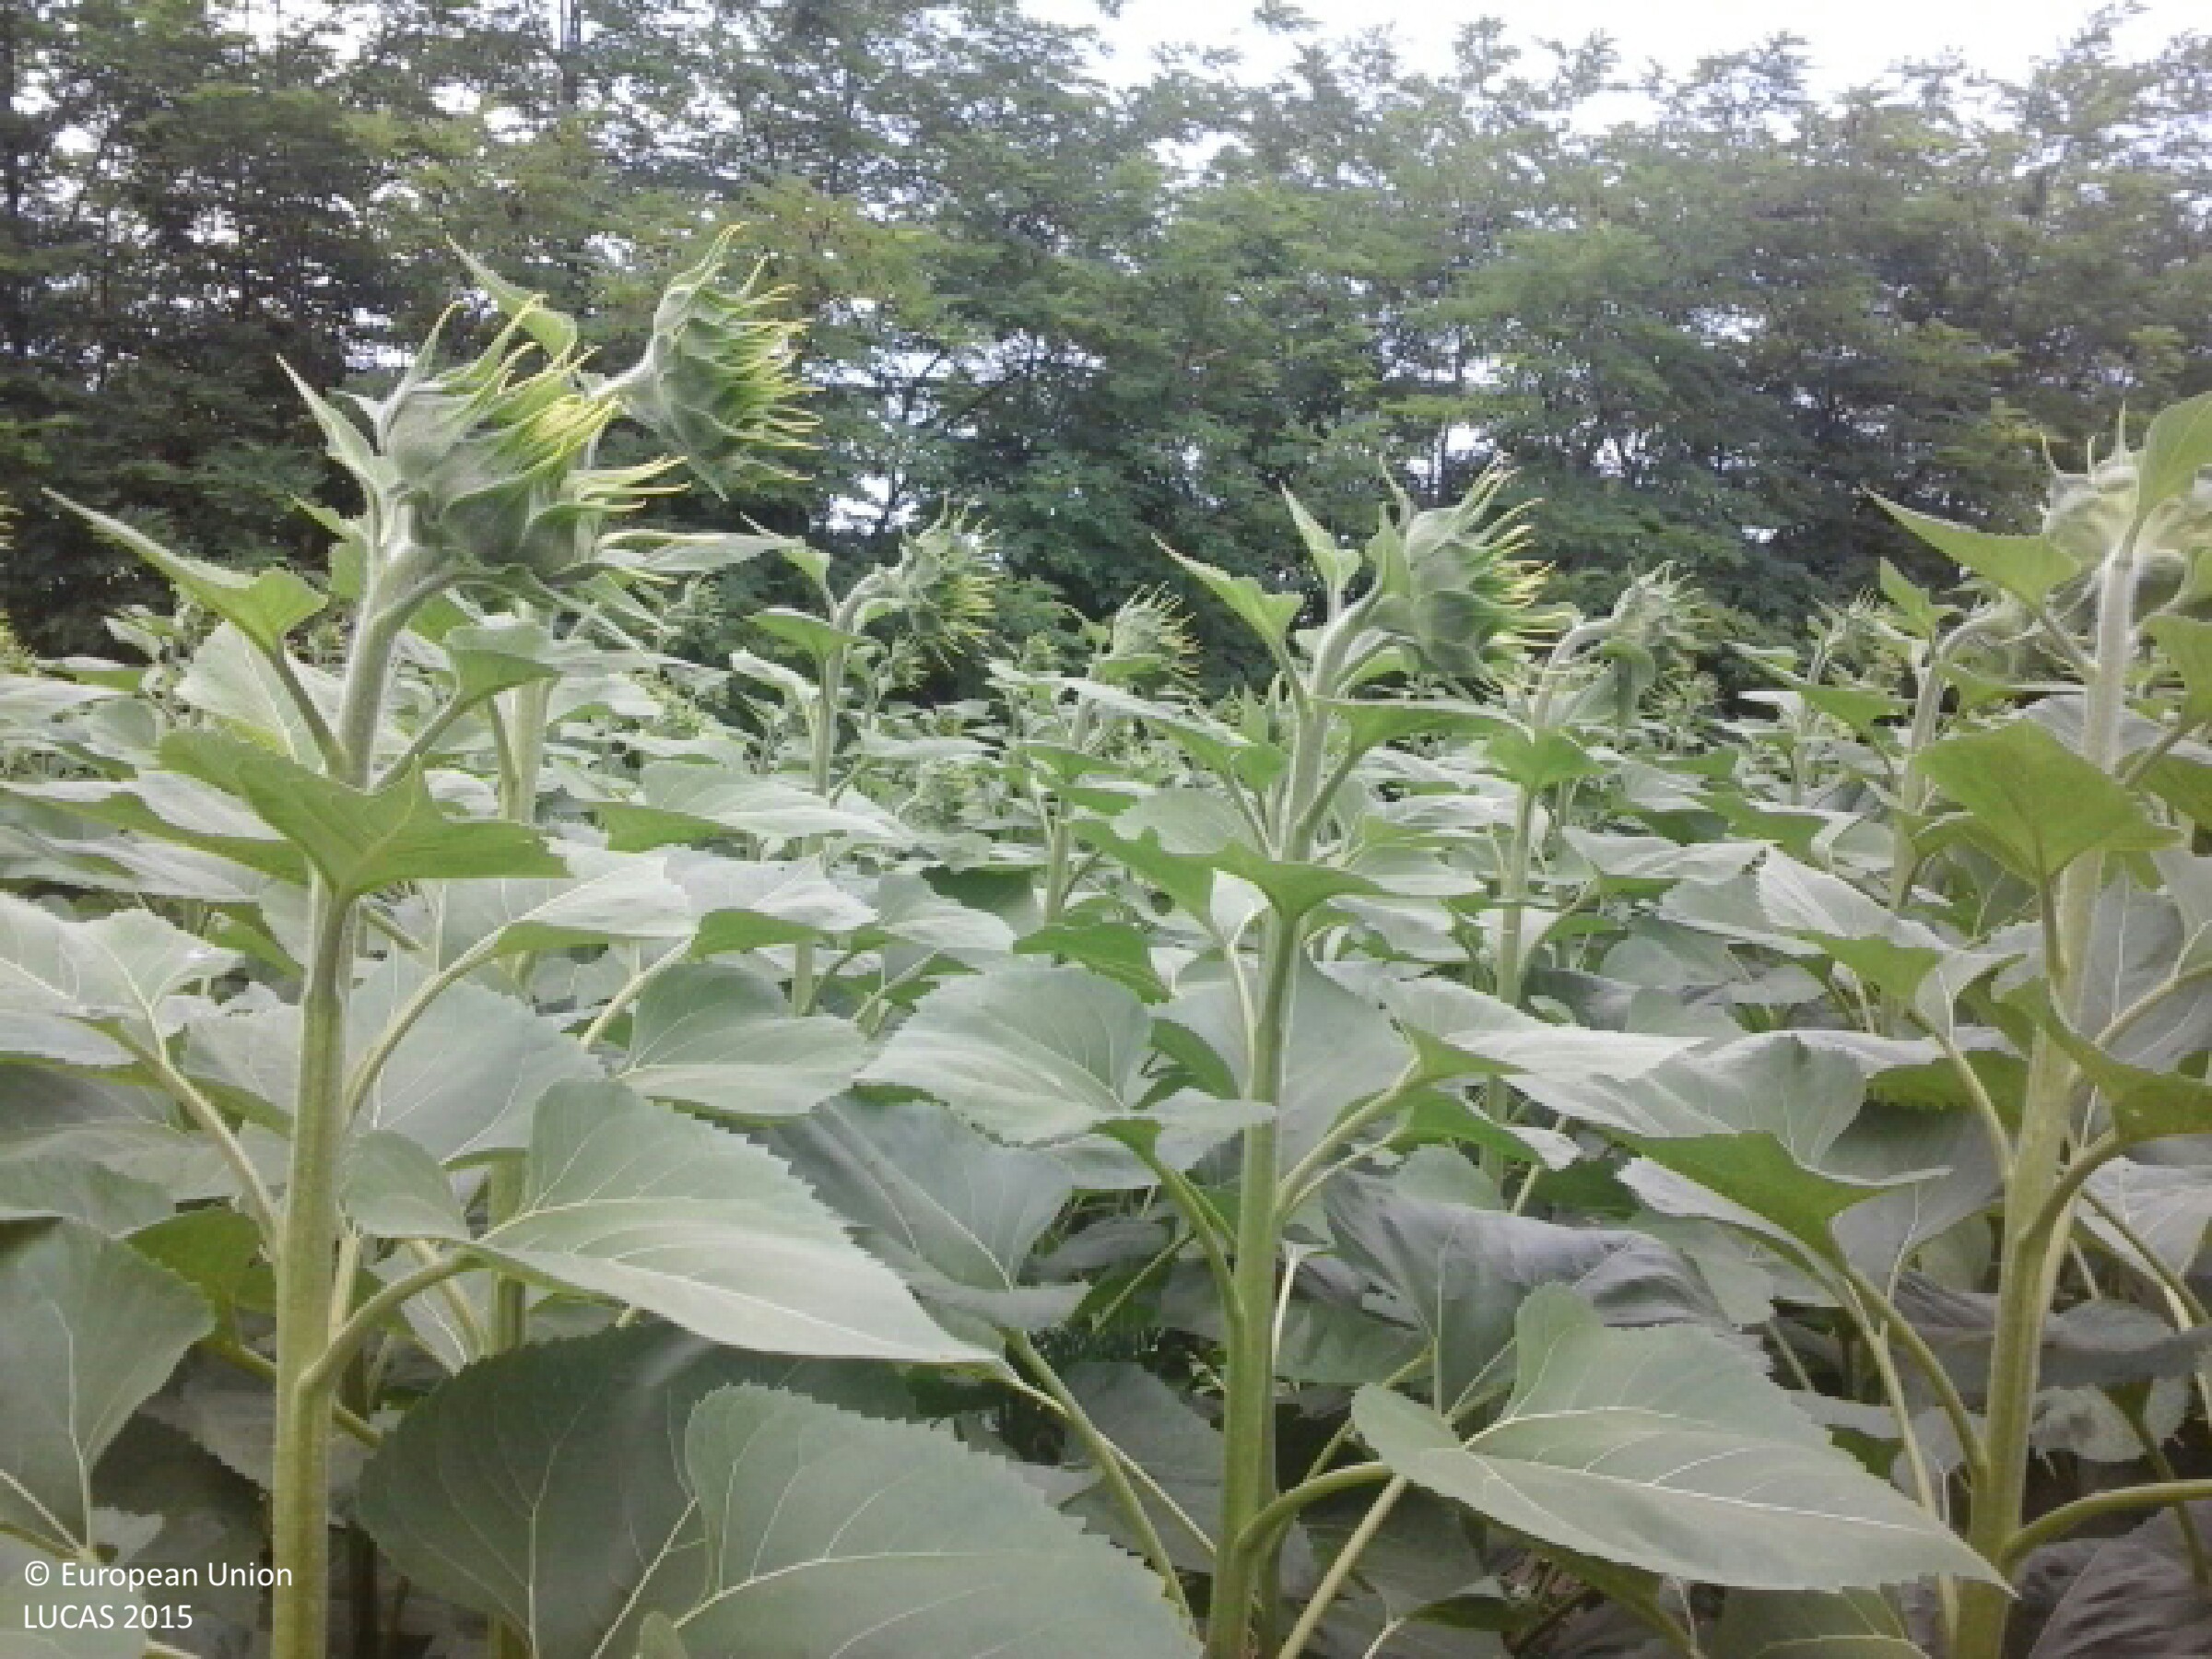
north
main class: Cropland
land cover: Sunflower
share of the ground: > 75 %
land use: Agriculture (excluding fallow land and kitchen gardens)
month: June
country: HU
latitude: 48.1679
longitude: 21.9792
